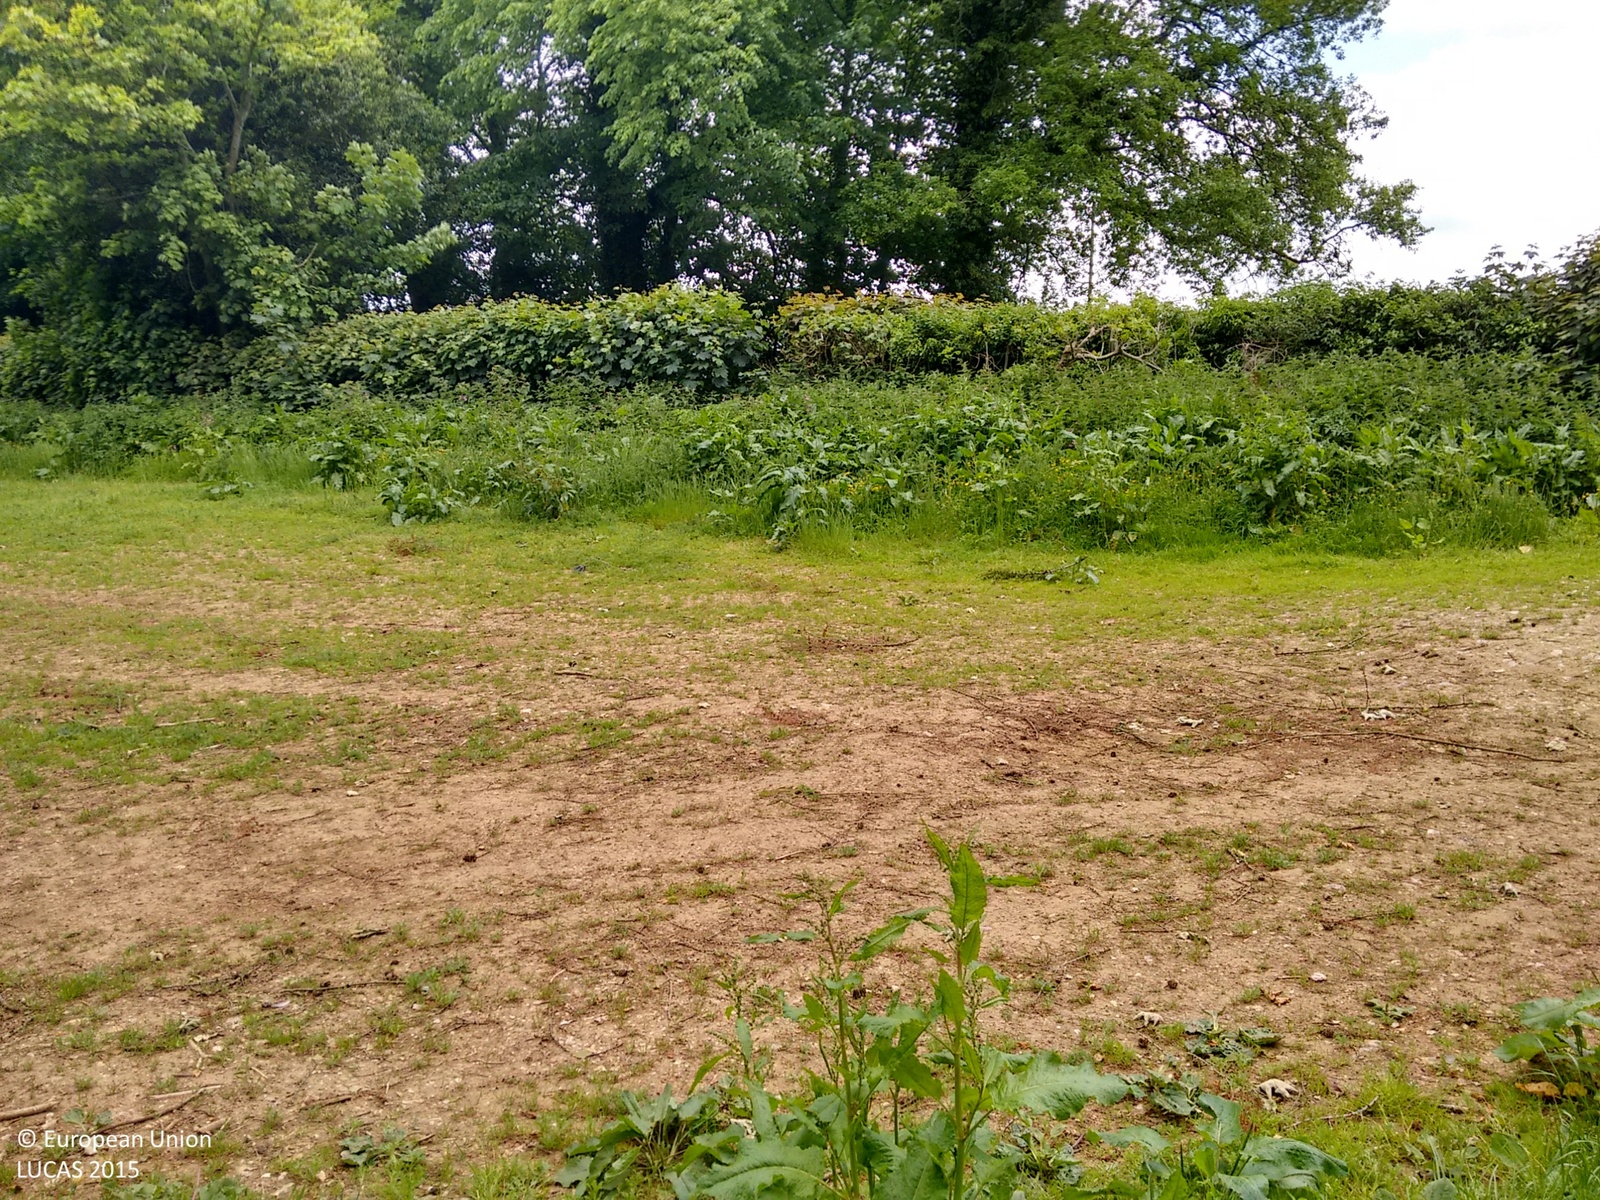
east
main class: Woodland
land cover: Broadleaved woodland
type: mesophytic deciduous forest
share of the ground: > 75 %
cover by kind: broadleaved forest trees 80 %, coniferous forest trees 20 %
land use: Semi-natural and natural areas not in use
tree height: > 5 m
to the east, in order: Broadleaved woodland; Shruby margins; Tracks; Shruby margins; Paved roads, cycling and walking lanes; Lines of trees; Fences; Spontaneously vegetated surfaces; Barley; Electric lines; Barley
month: June
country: GB
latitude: 51.0628
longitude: -2.1175
